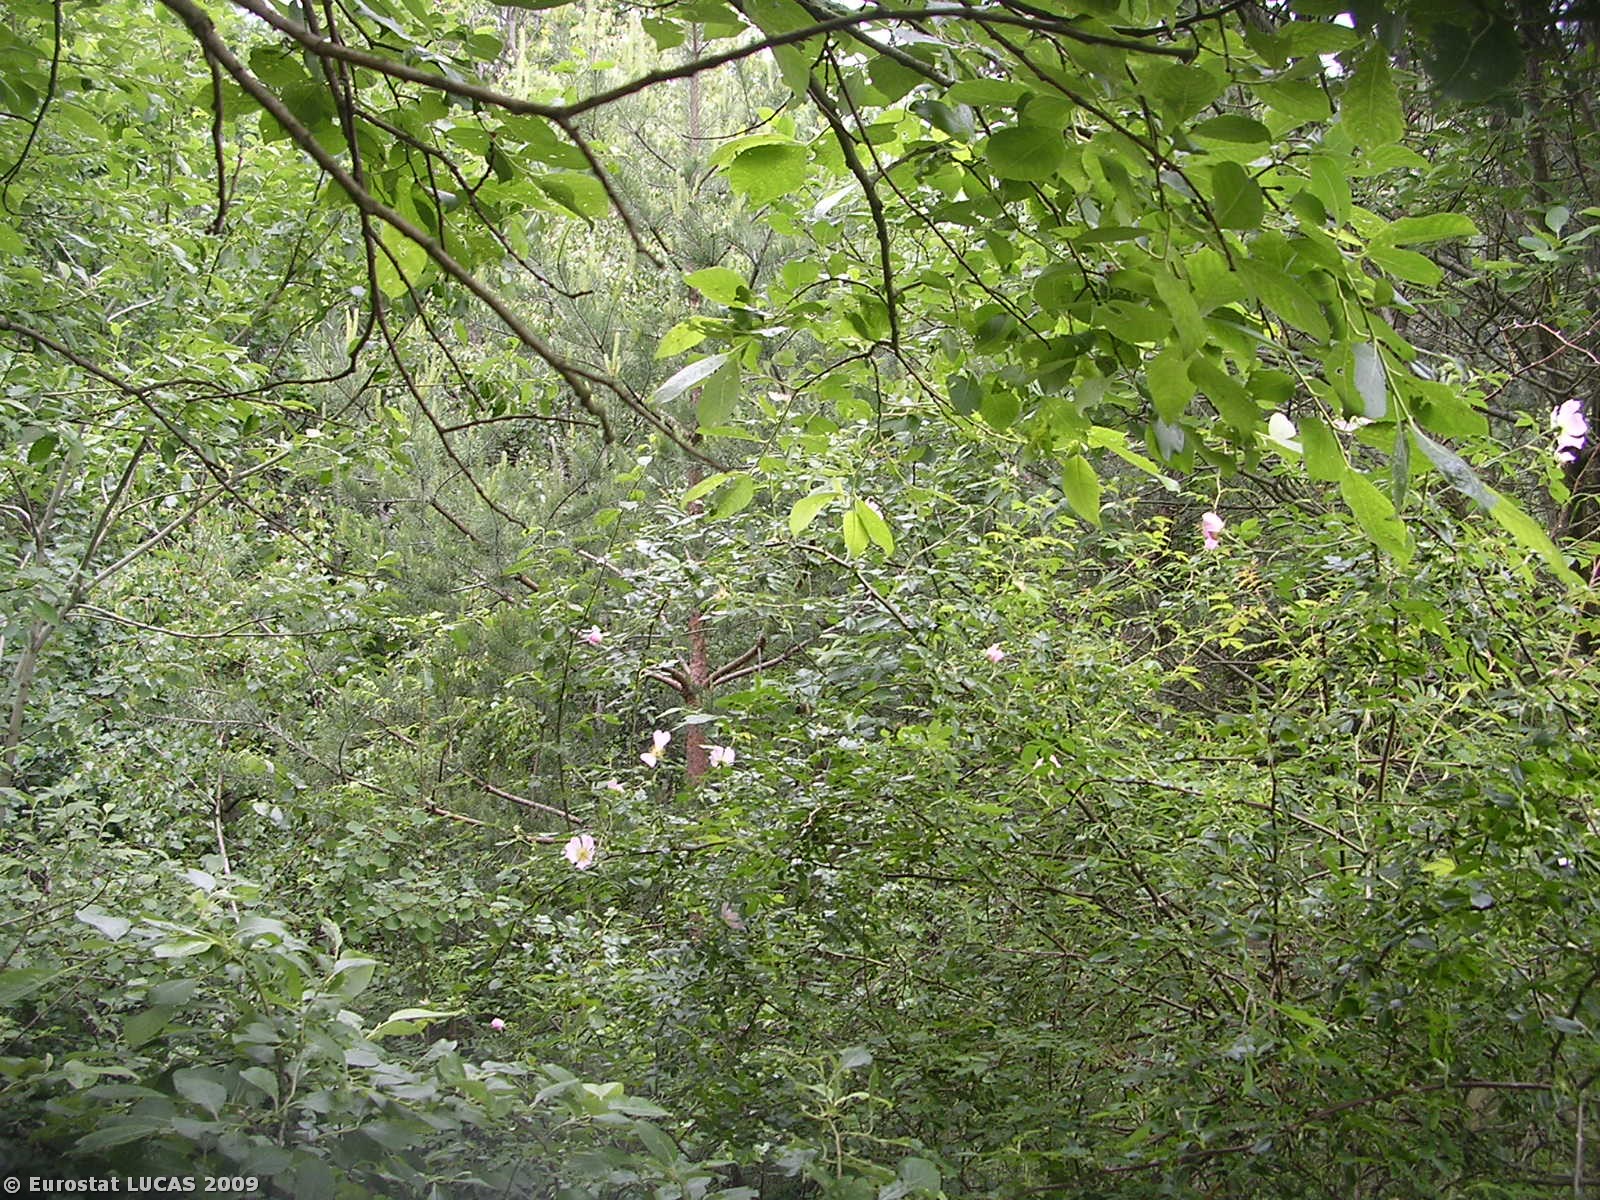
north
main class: Woodland
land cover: Broadleaved woodland
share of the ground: > 75 %
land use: Forestry
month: June
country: CZ
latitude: 50.5399
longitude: 14.6444
